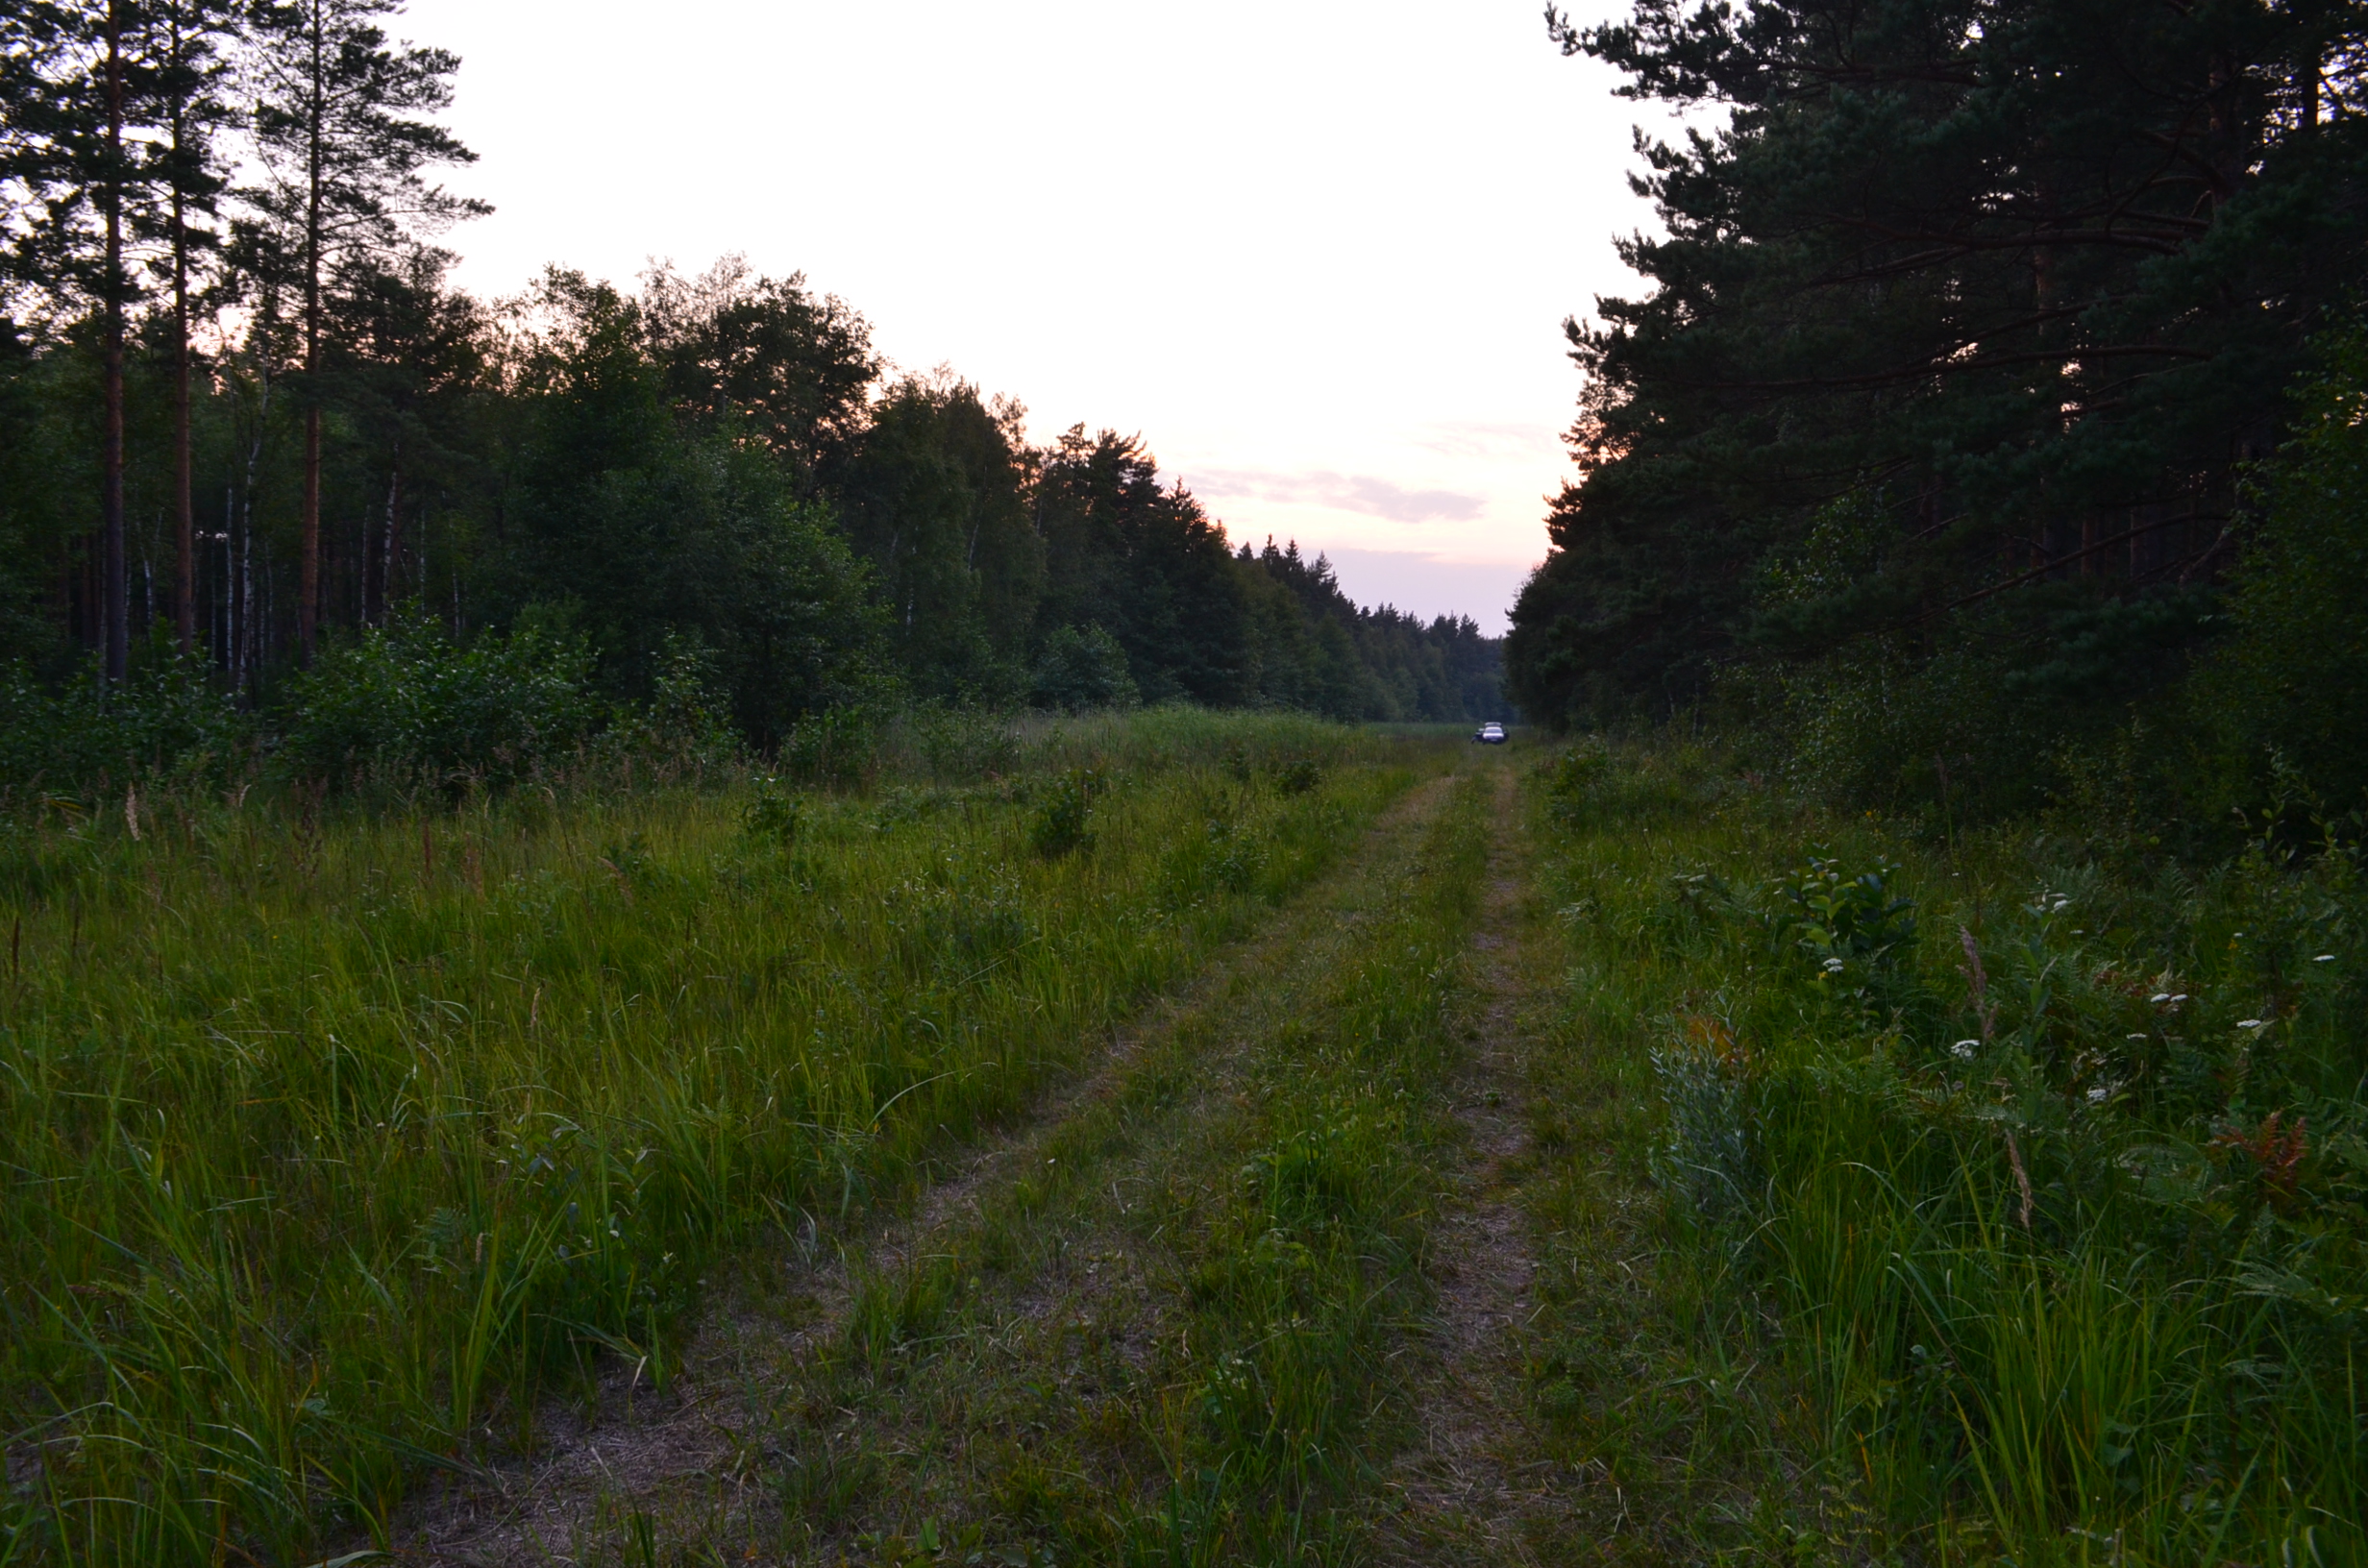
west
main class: Woodland
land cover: Pine dominated mixed woodland
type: hemiboreal forest and nemoral coniferous forest and mixed broadleaved-coniferous forest
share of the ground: > 75 %
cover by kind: broadleaved forest trees 55 %, coniferous forest trees 40 %, herbaceous plants 4 %, shrubs 1 %
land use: Forestry
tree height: > 5 m
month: August
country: LV
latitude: 57.4200
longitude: 21.6460
